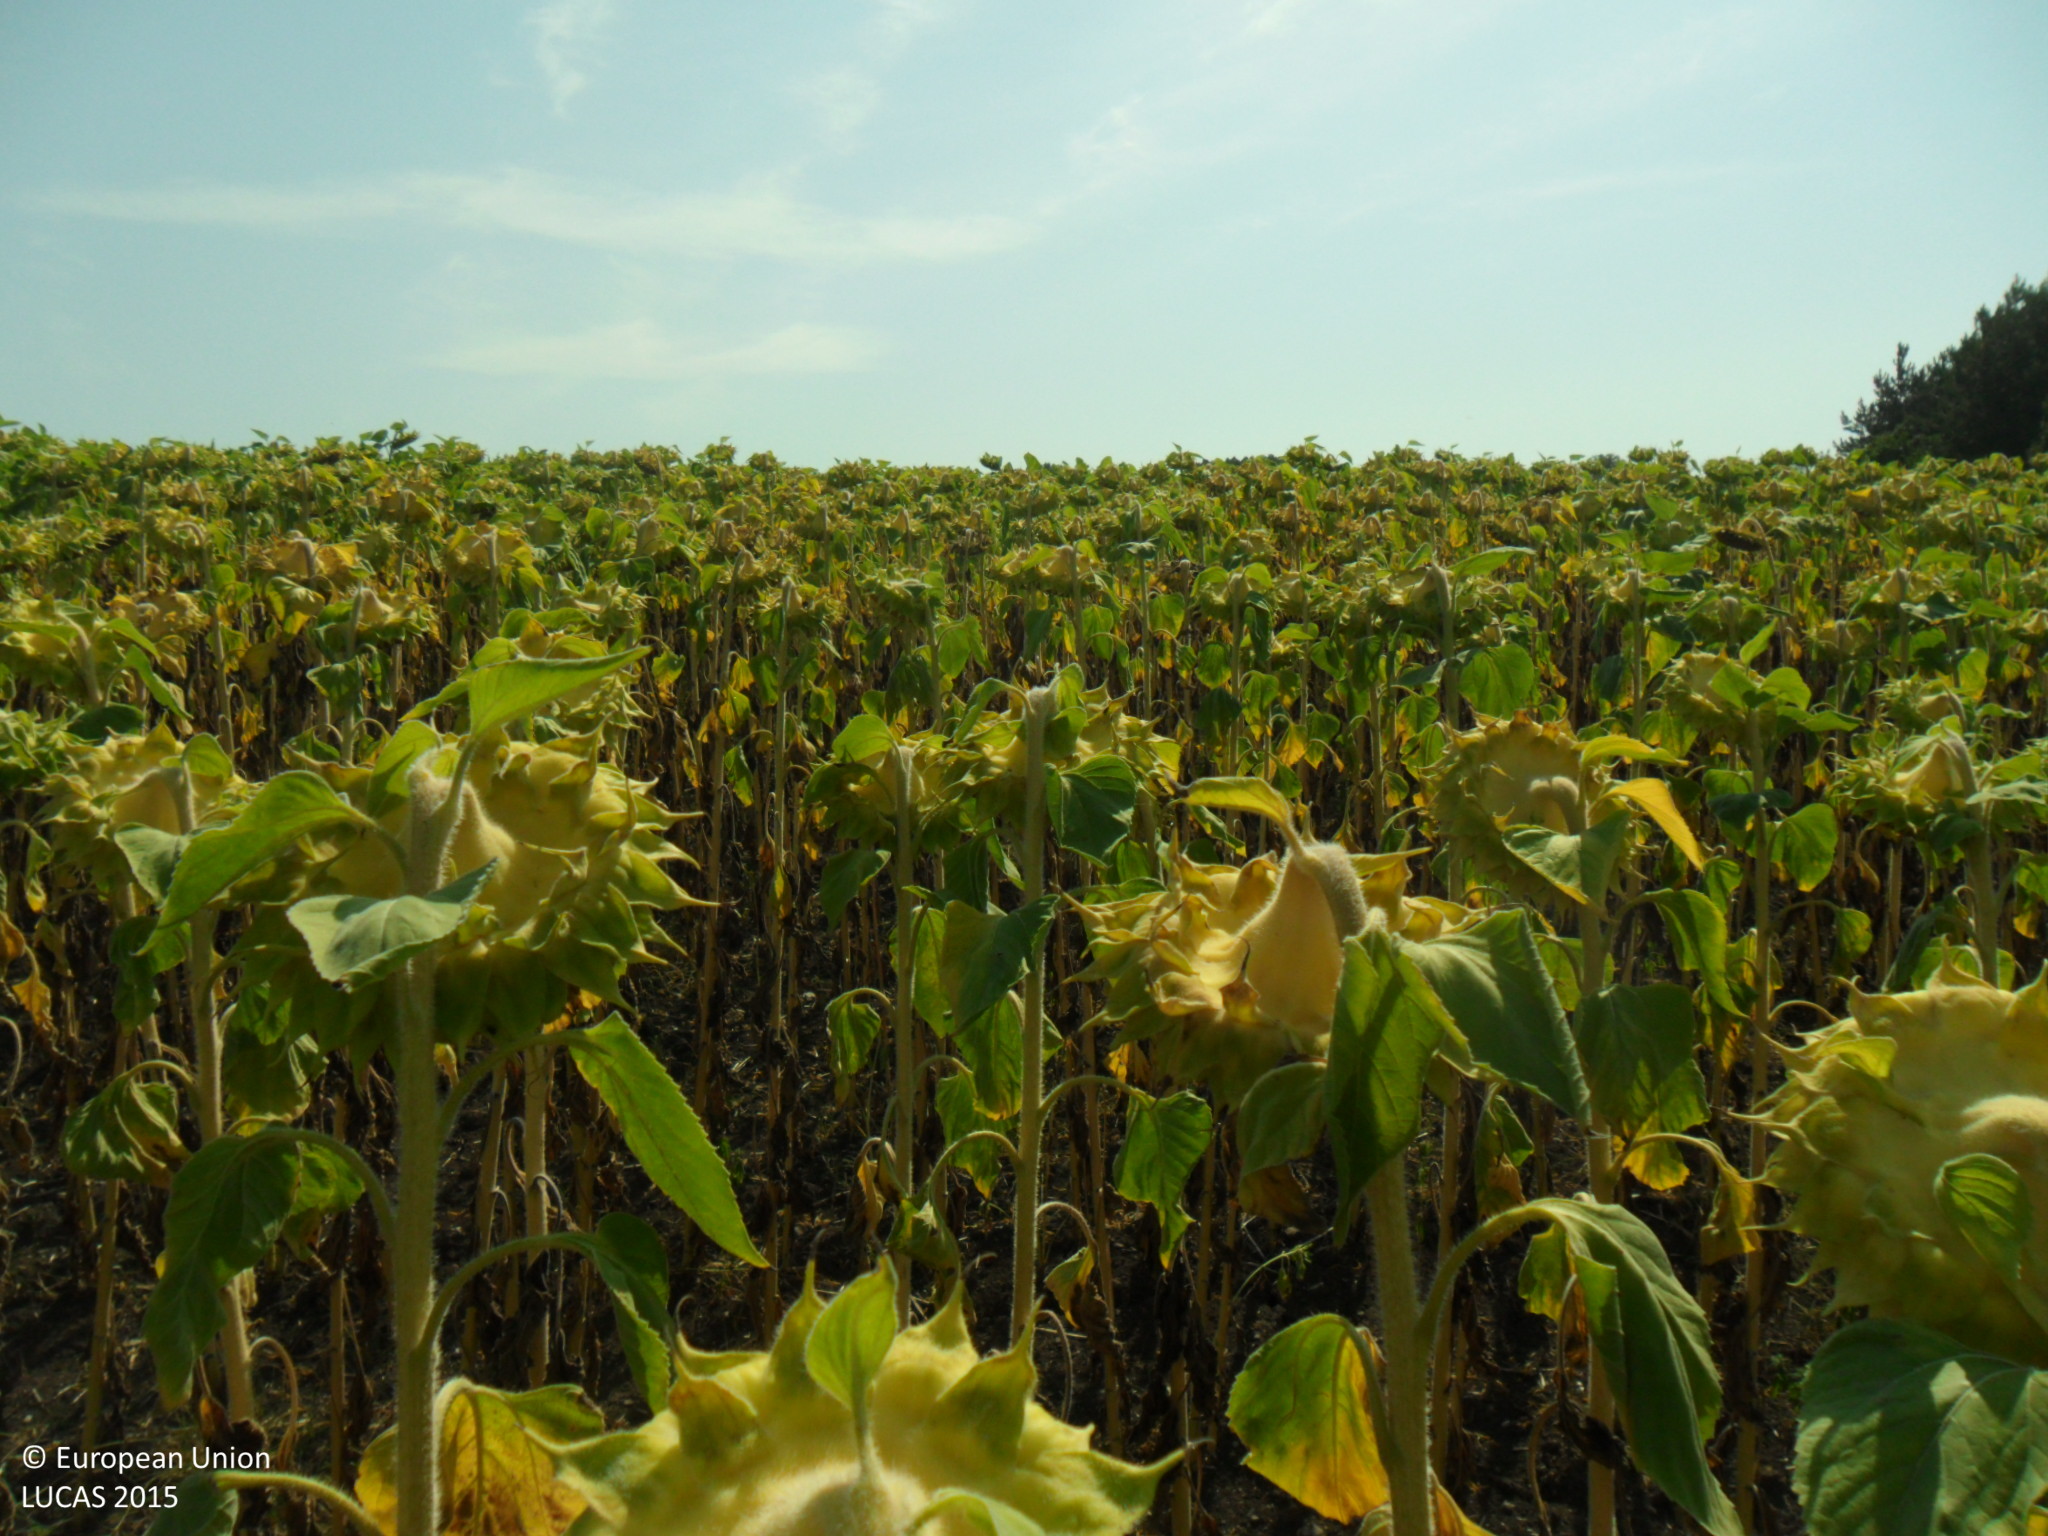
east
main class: Cropland
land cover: Sunflower
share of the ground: > 75 %
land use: Agriculture (excluding fallow land and kitchen gardens)
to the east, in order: Sunflower
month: August
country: BG
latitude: 43.3856
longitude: 26.8382
